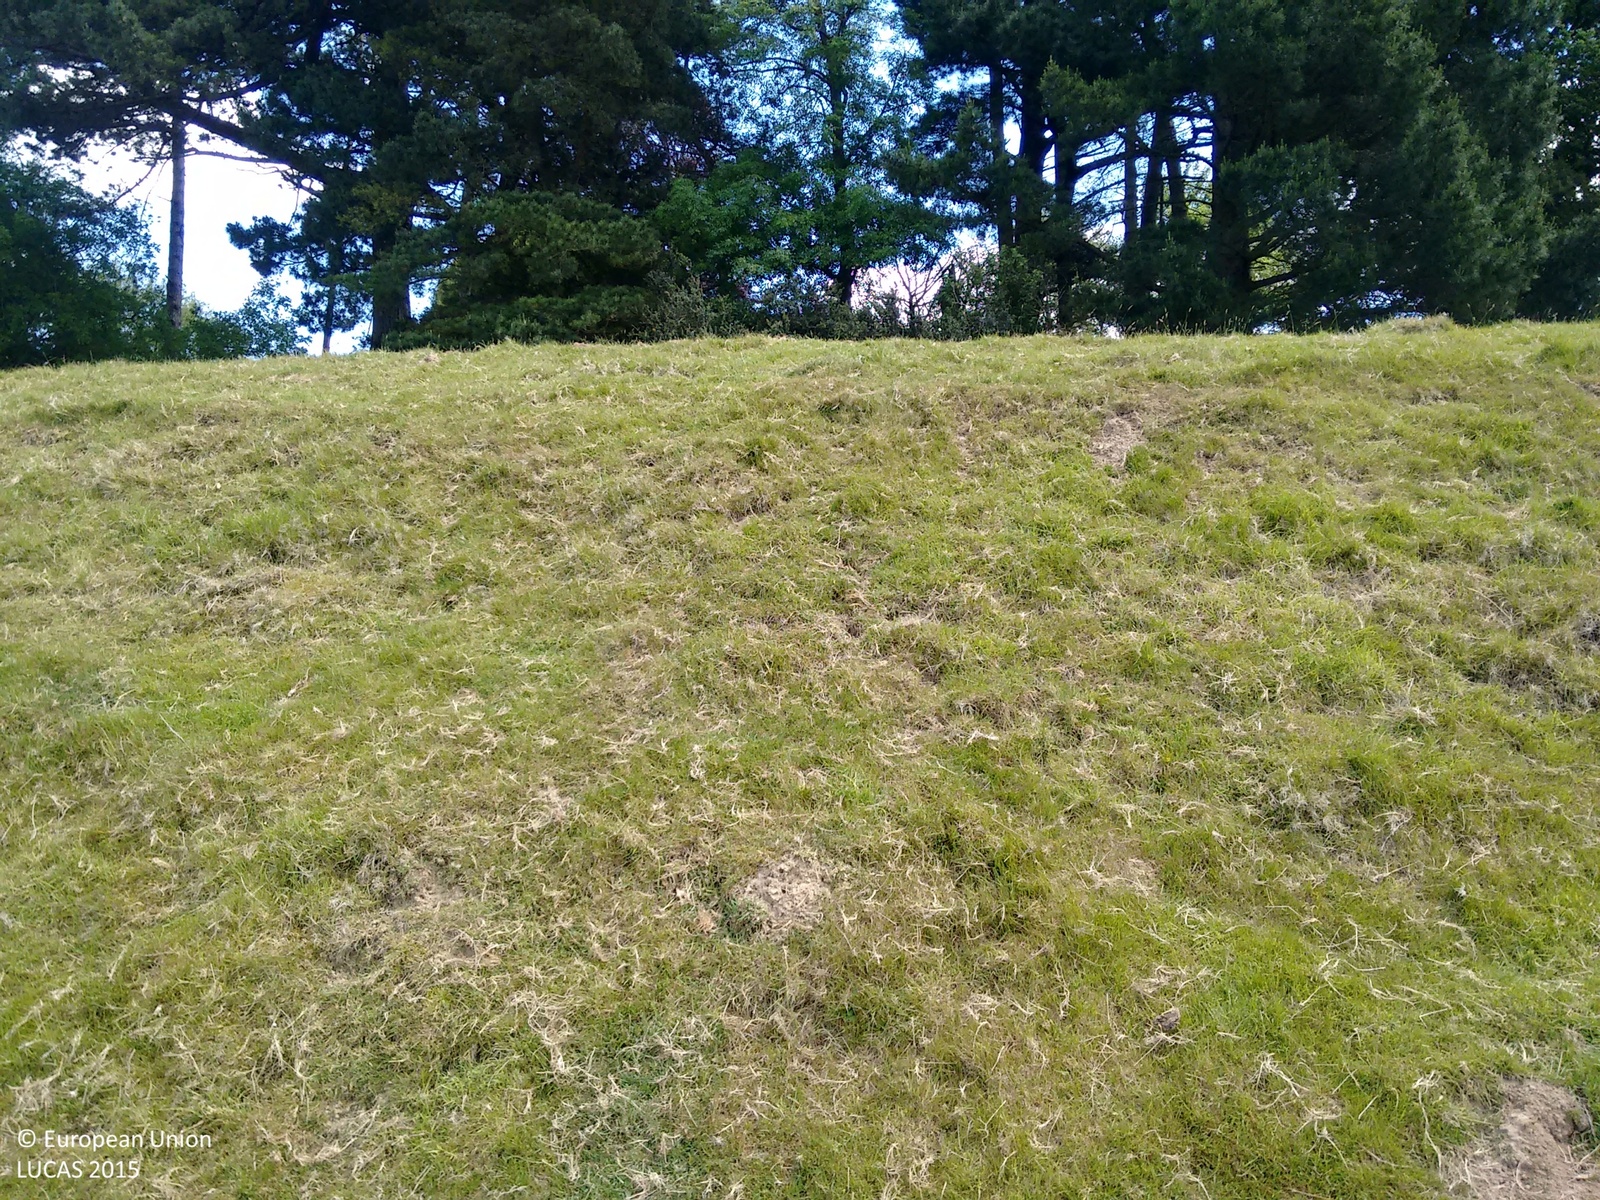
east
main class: Grassland
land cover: Grassland without tree/shrub cover
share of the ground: > 75 %
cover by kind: herbaceous plants 100 %
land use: Agriculture (excluding fallow land and kitchen gardens)
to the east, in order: Grassland without tree/shrub cover; Fences; Grassland without tree/shrub cover; Fences; Other mixed woodland; Artificial constructions in urban areas; Tracks; Fences; Electric lines; Grassland without tree/shrub cover
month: June
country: GB
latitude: 50.9422
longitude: 0.6804
